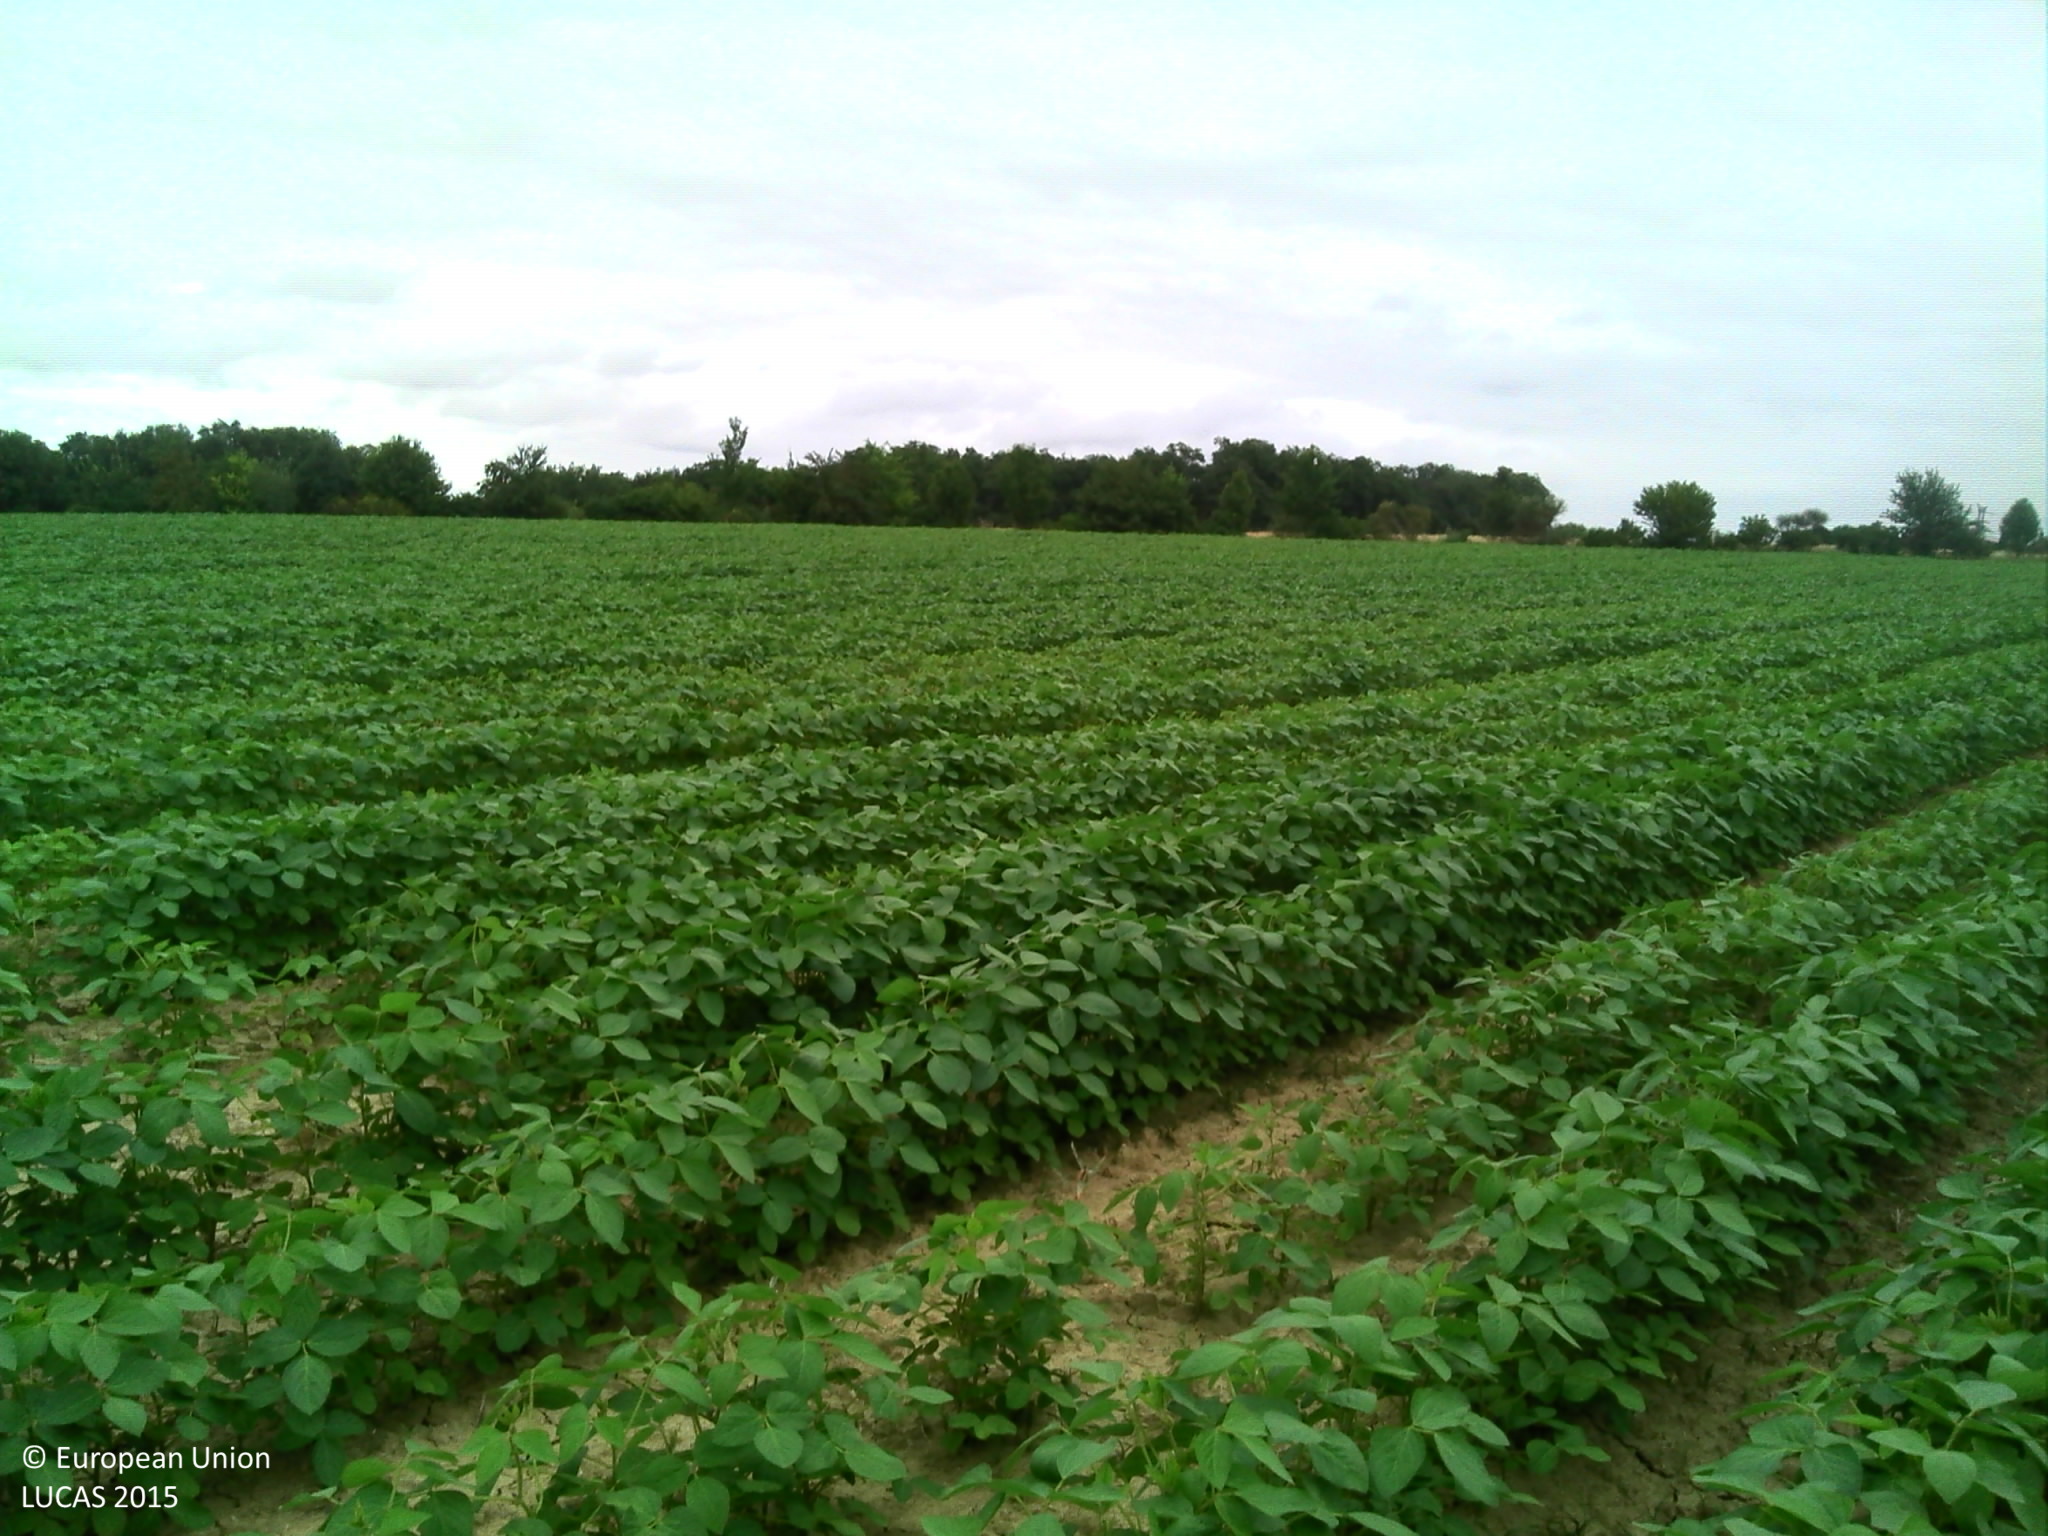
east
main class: Cropland
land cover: Soya
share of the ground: > 75 %
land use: Agriculture (excluding fallow land and kitchen gardens)
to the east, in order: Soya; Lines of trees; Grass margins; Tracks; Barley; Broadleaved woodland
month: July
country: FR
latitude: 43.4845
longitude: 1.6086
